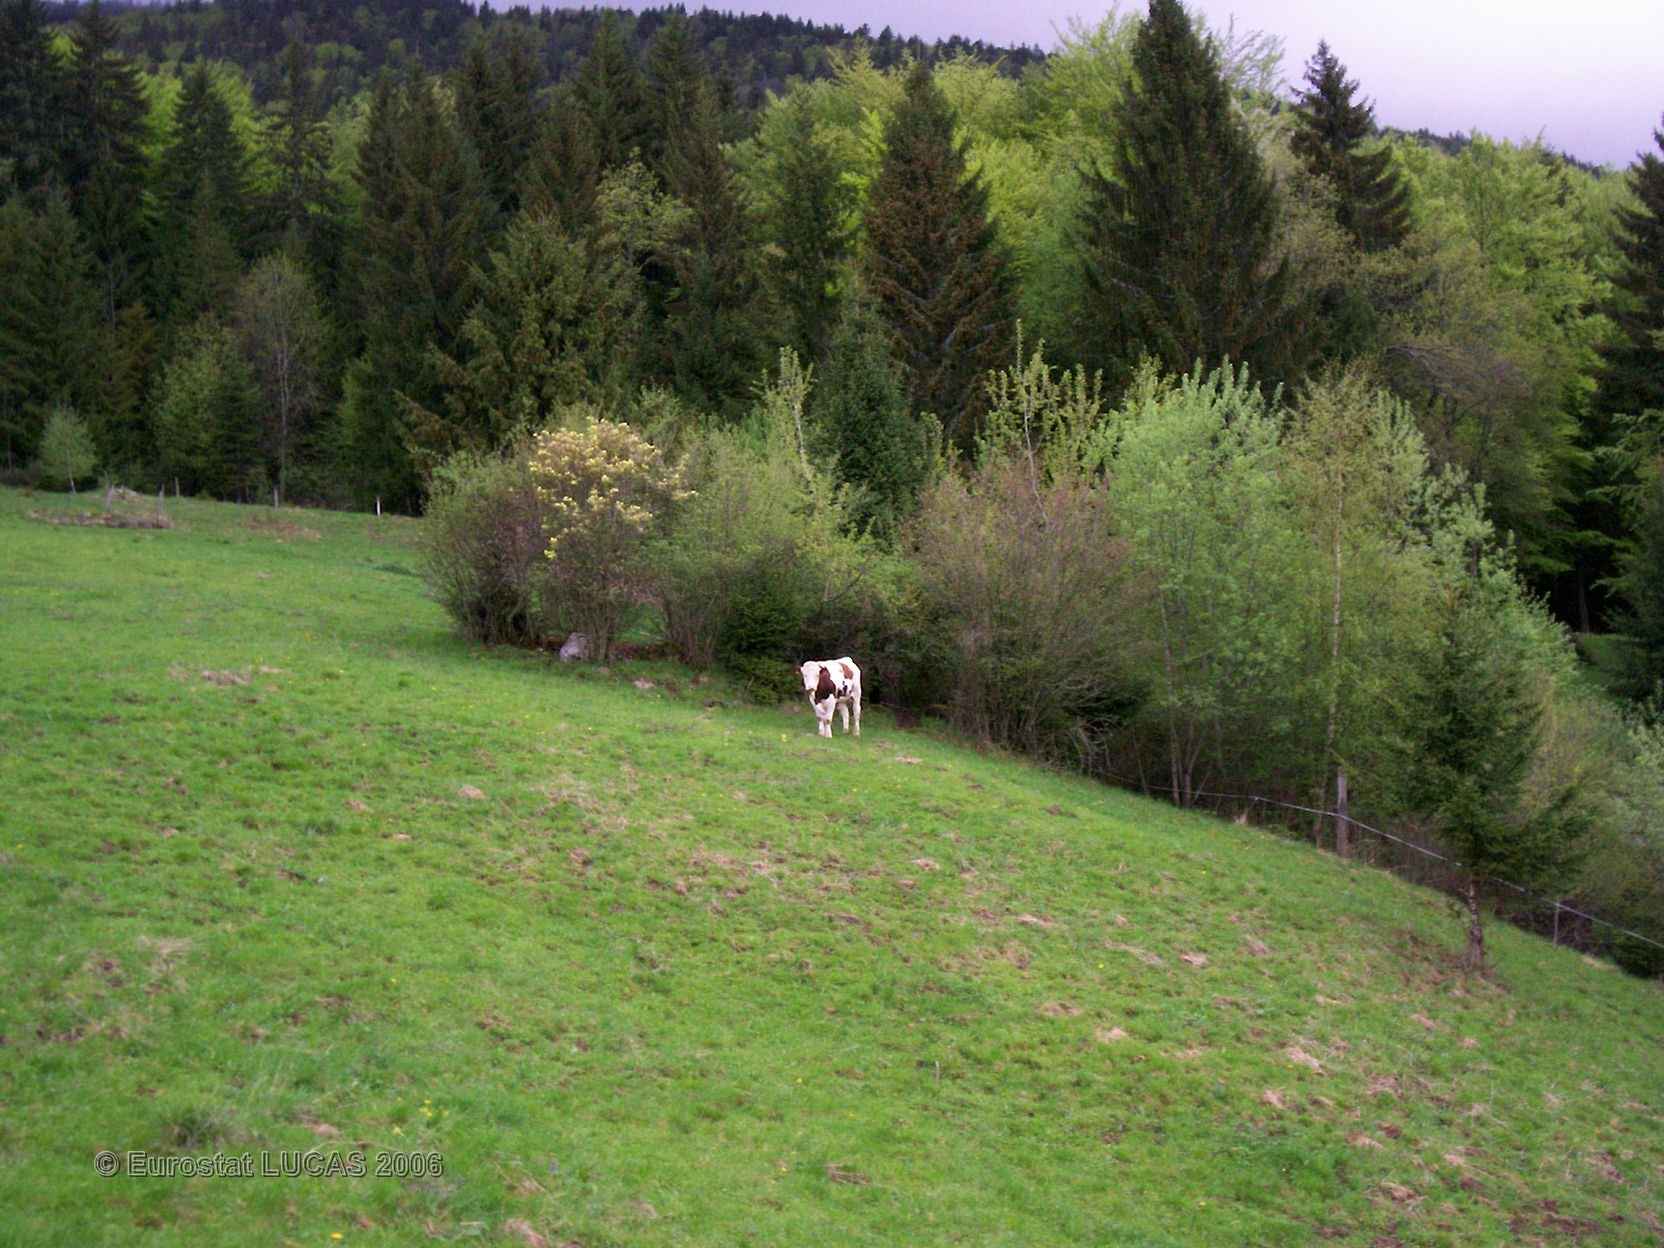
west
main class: Grassland
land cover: Grassland without tree/shrub cover
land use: Agriculture (excluding fallow land and kitchen gardens)
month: May
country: FR
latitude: 45.7944
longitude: 6.1318
